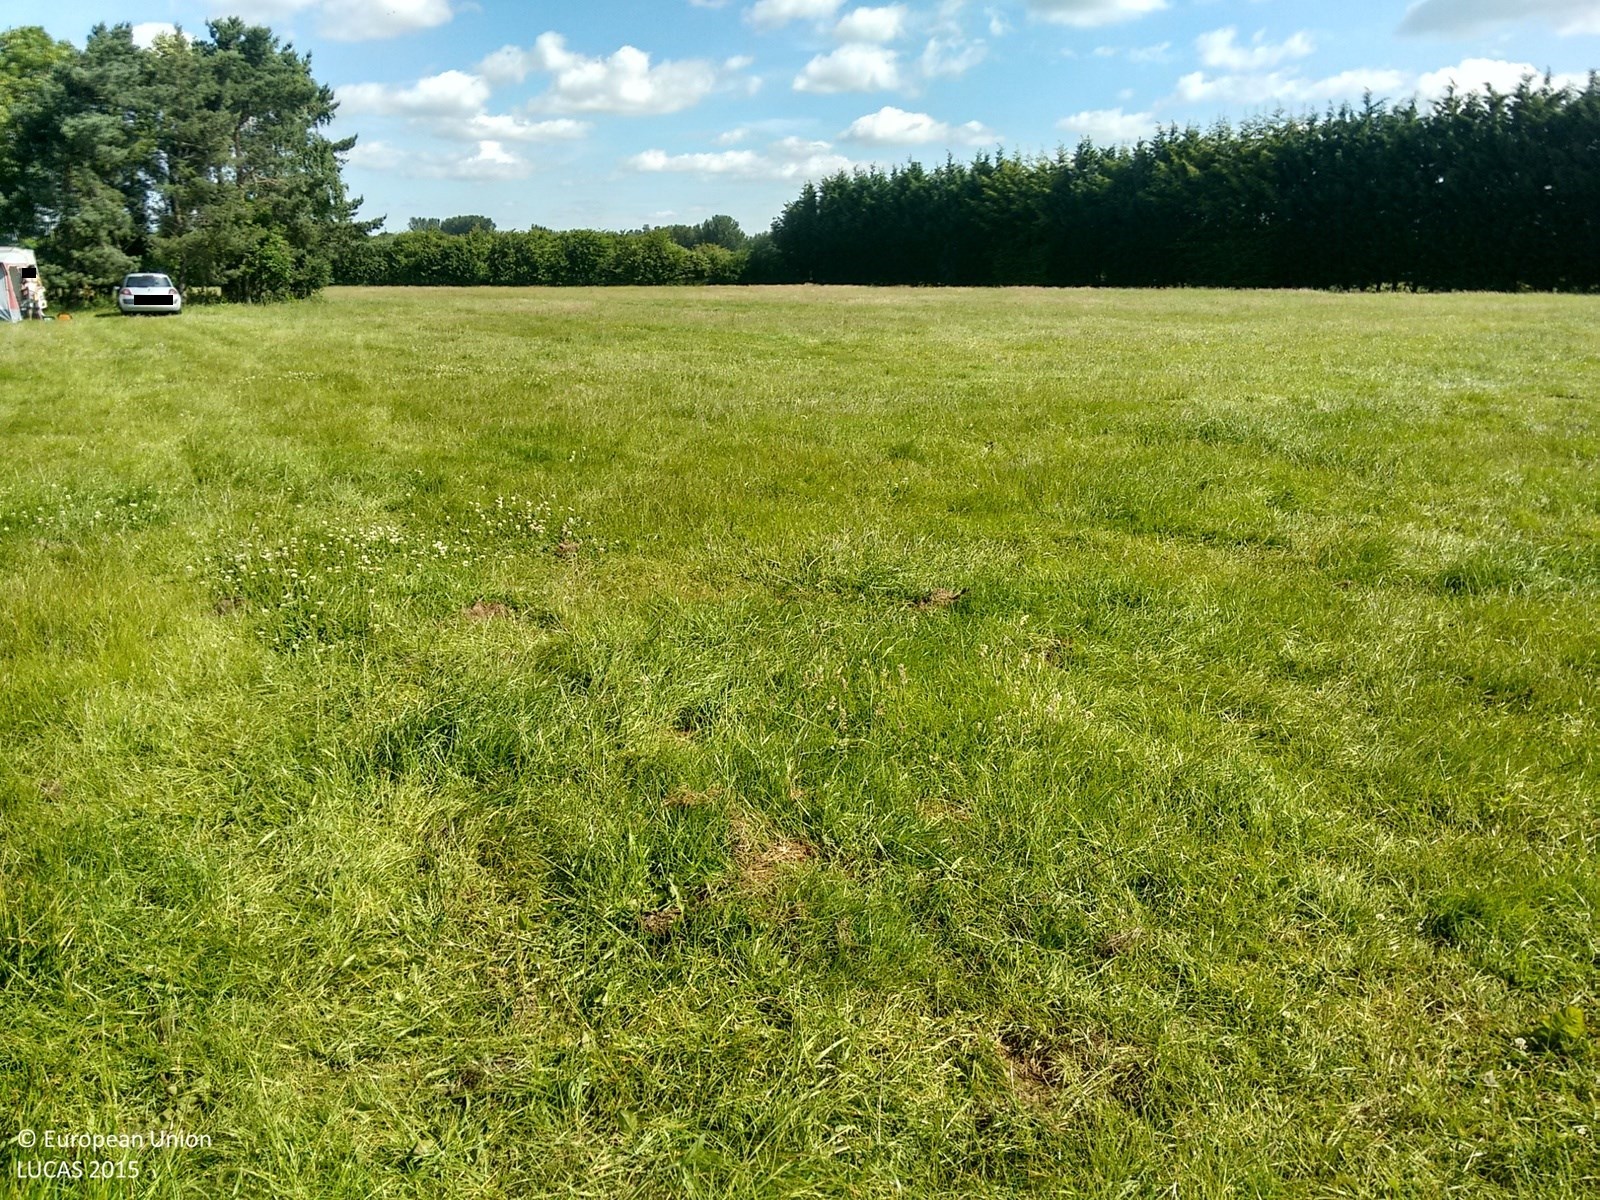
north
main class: Grassland
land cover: Grassland without tree/shrub cover
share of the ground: > 75 %
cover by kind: herbaceous plants 100 %
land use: Sport
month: June
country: GB
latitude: 52.0862
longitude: -2.0703
